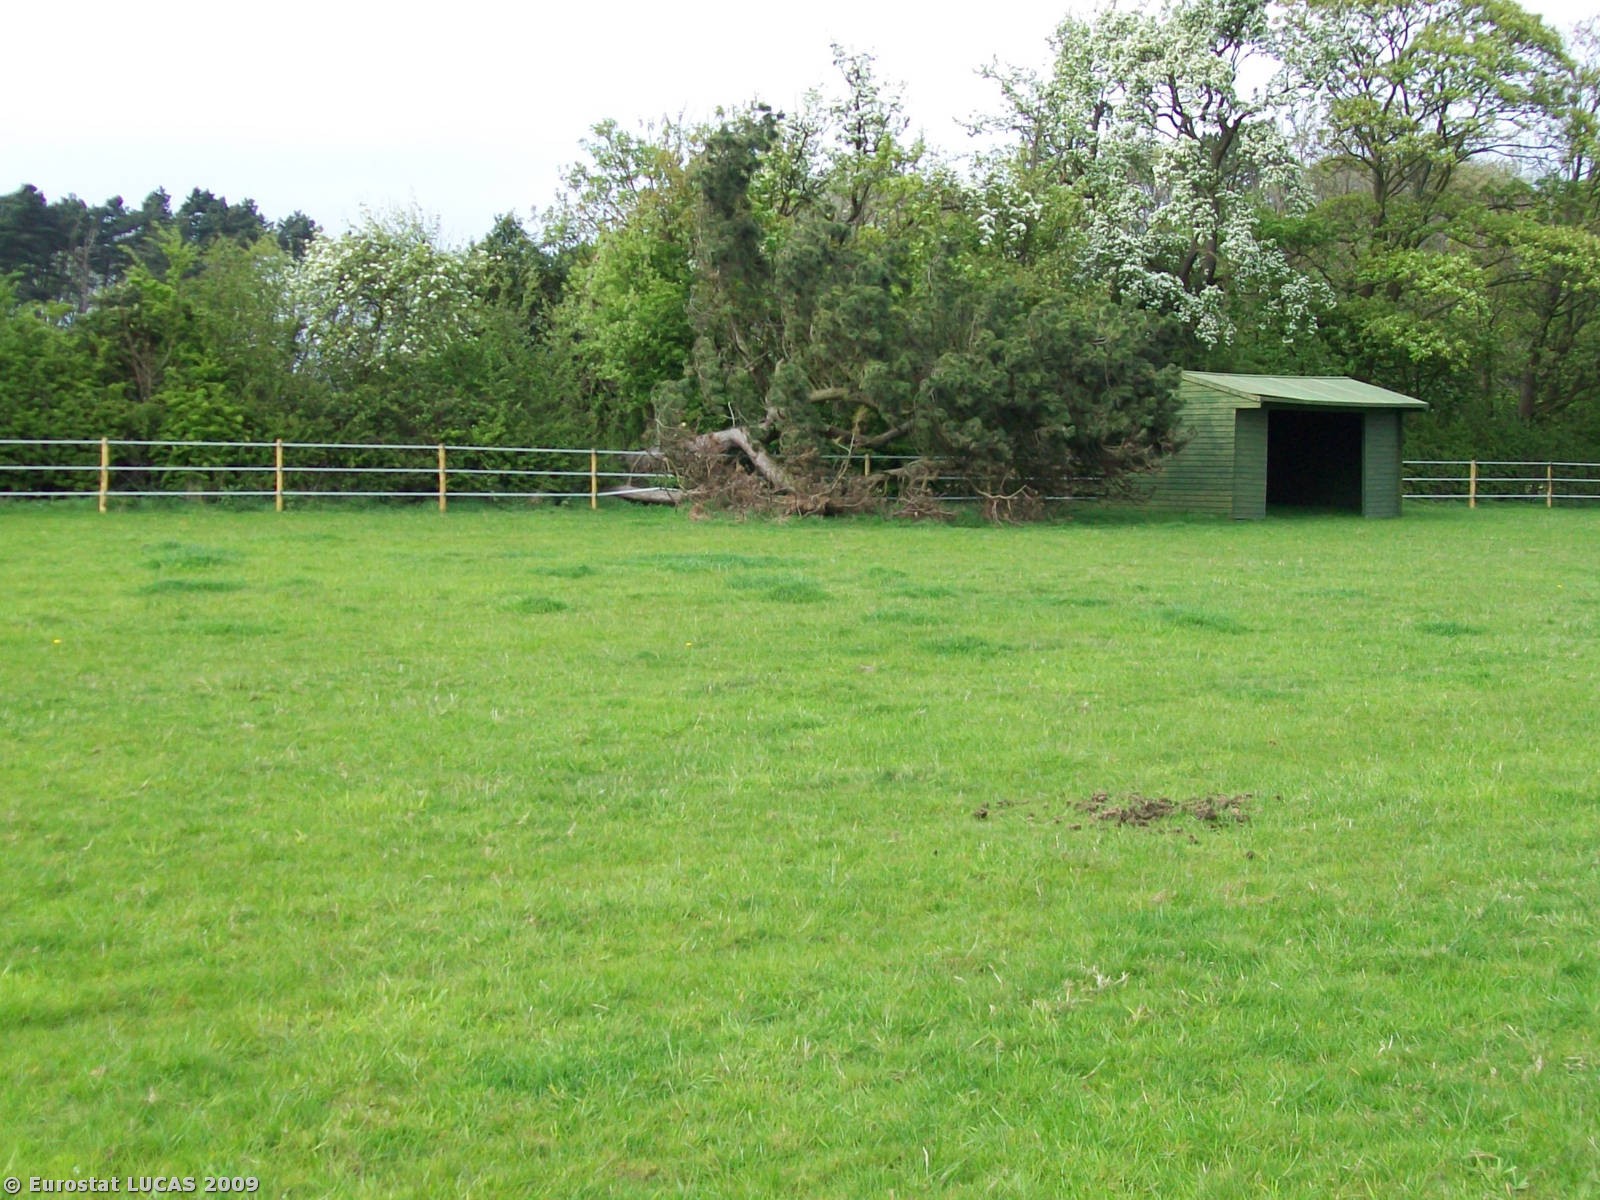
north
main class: Grassland
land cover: Grassland without tree/shrub cover
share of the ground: 50 - 75 %
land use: Agriculture (excluding fallow land and kitchen gardens)
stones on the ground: < 10 %
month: April
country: GB
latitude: 53.5447
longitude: -2.9153
